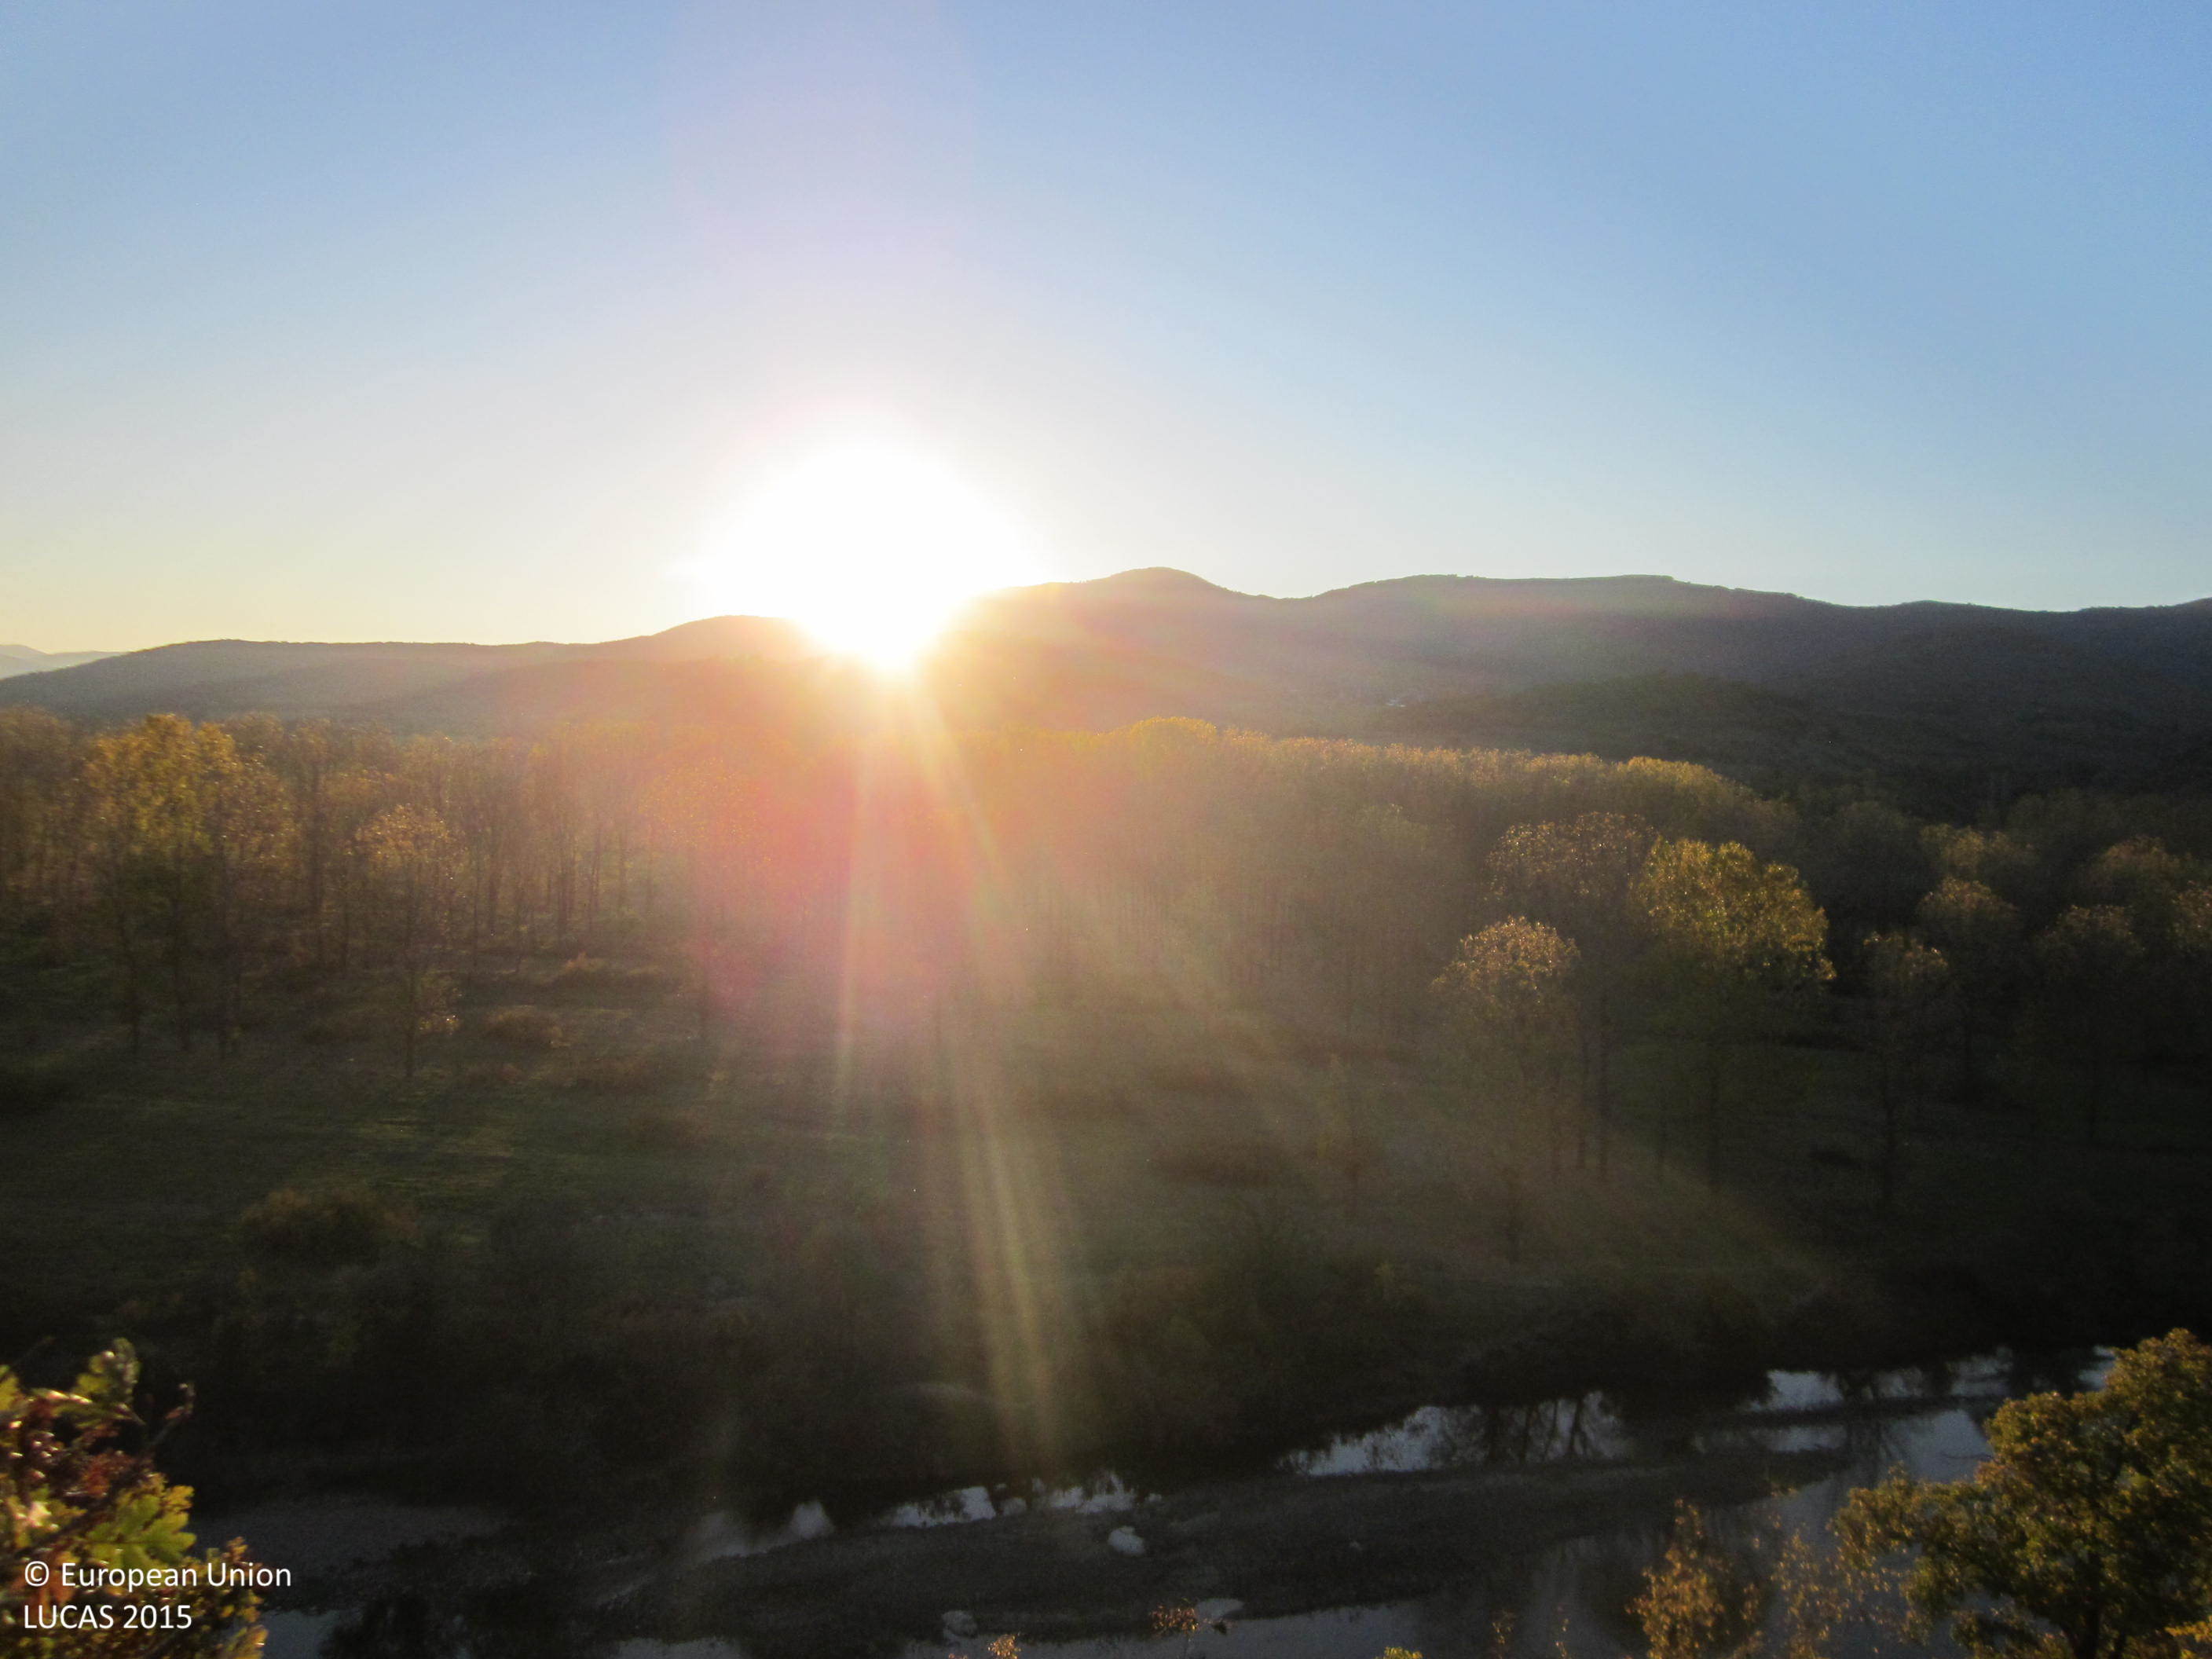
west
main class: Woodland
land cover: Broadleaved woodland
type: acidophilous oak and oak-birch forest
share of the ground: 50 - 75 %
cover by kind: broadleaved forest trees 75 %, herbaceous plants 15 %, shrubs 5 %, unconsolidated bare surface 5 %
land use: Forestry
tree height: > 5 m
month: November
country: BG
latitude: 41.5557
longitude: 25.6601
